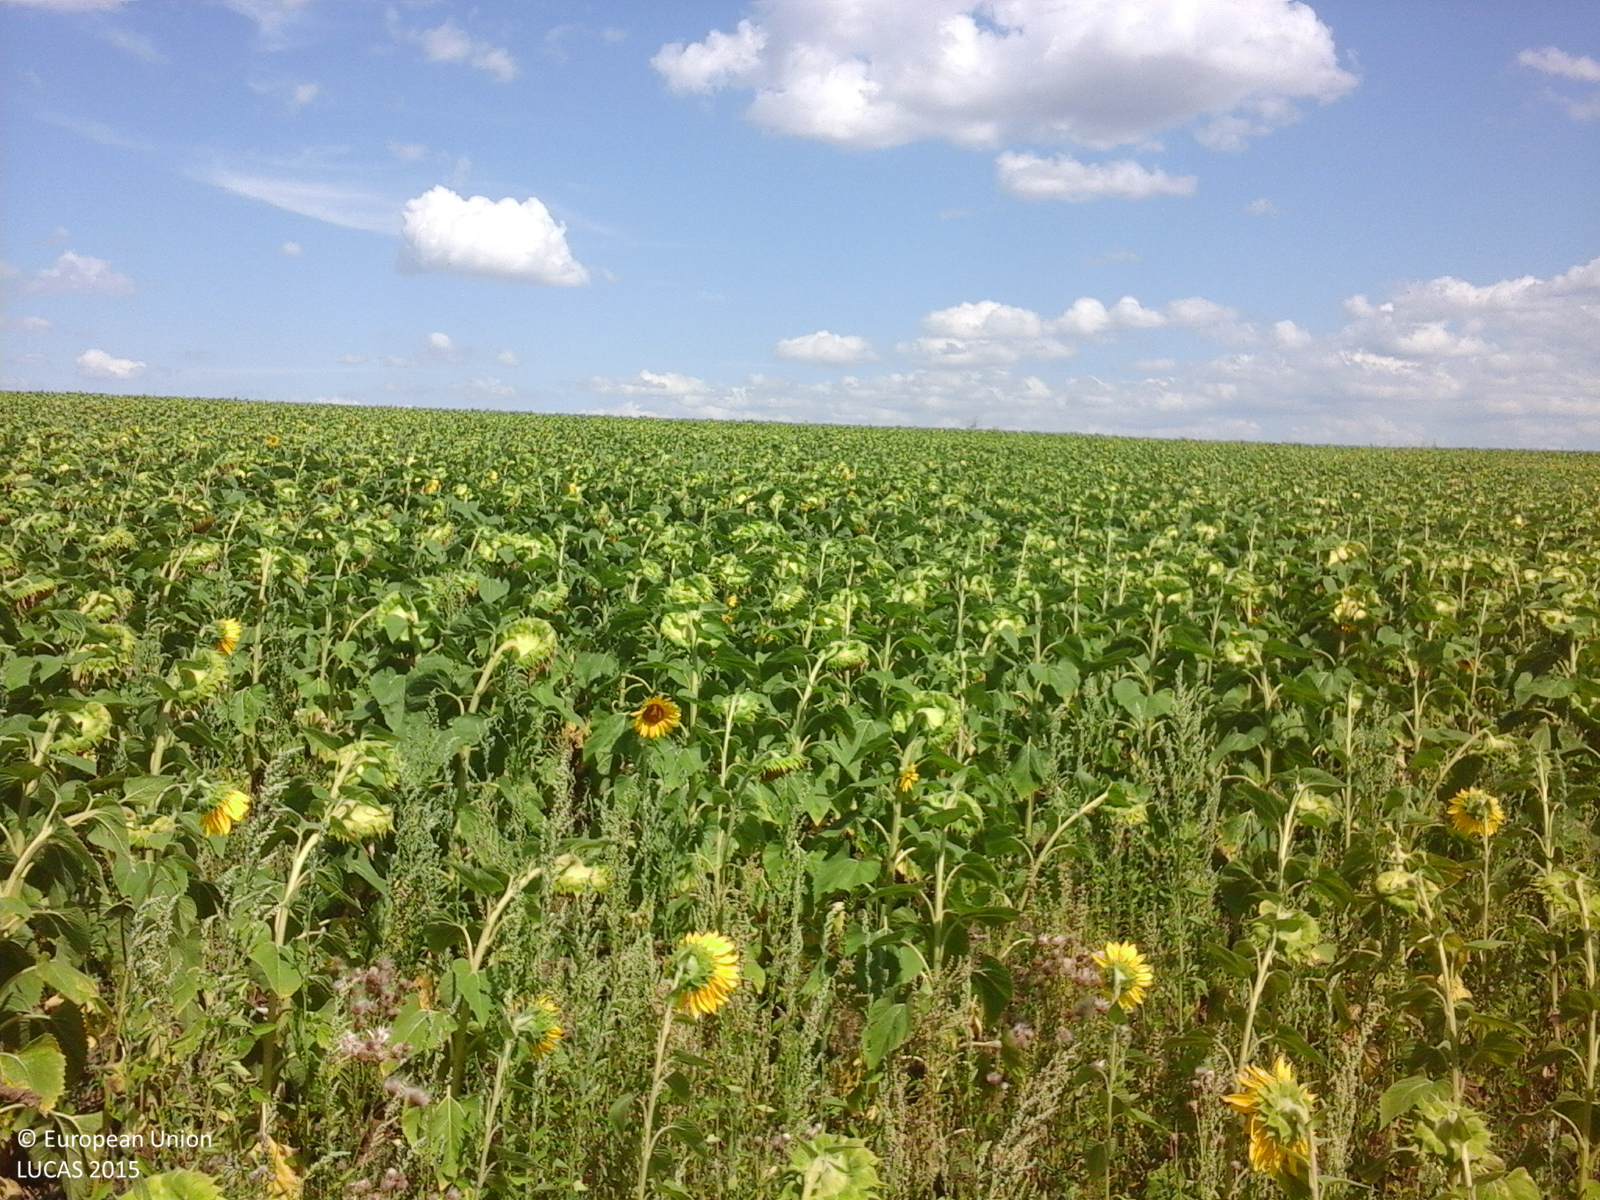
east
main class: Cropland
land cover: Sunflower
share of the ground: > 75 %
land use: Agriculture (excluding fallow land and kitchen gardens)
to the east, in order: Sunflower
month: July
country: RO
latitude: 46.4618
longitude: 28.1389
